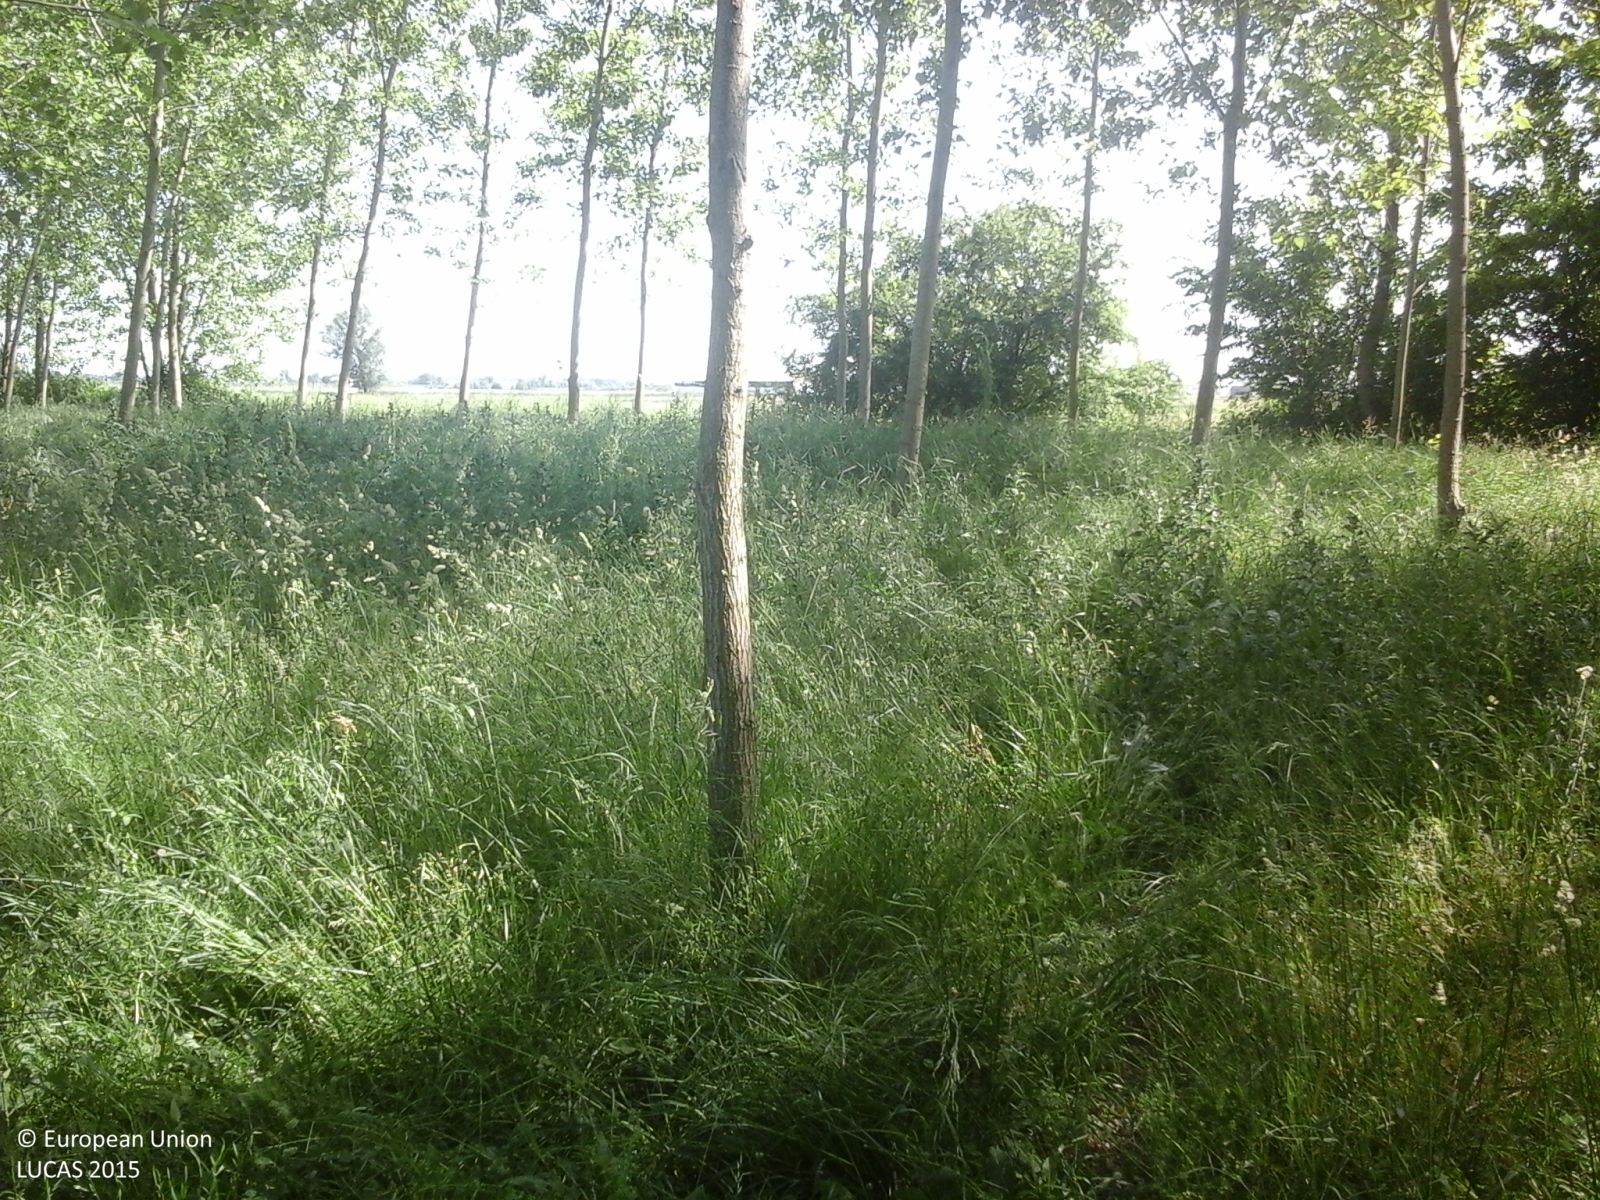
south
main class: Woodland
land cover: Broadleaved woodland
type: non-riverine alder, birch or aspen forest
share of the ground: > 75 %
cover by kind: broadleaved forest trees 100 %
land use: Forestry
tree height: > 5 m
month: May
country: IT
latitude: 45.0307
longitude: 11.0261
